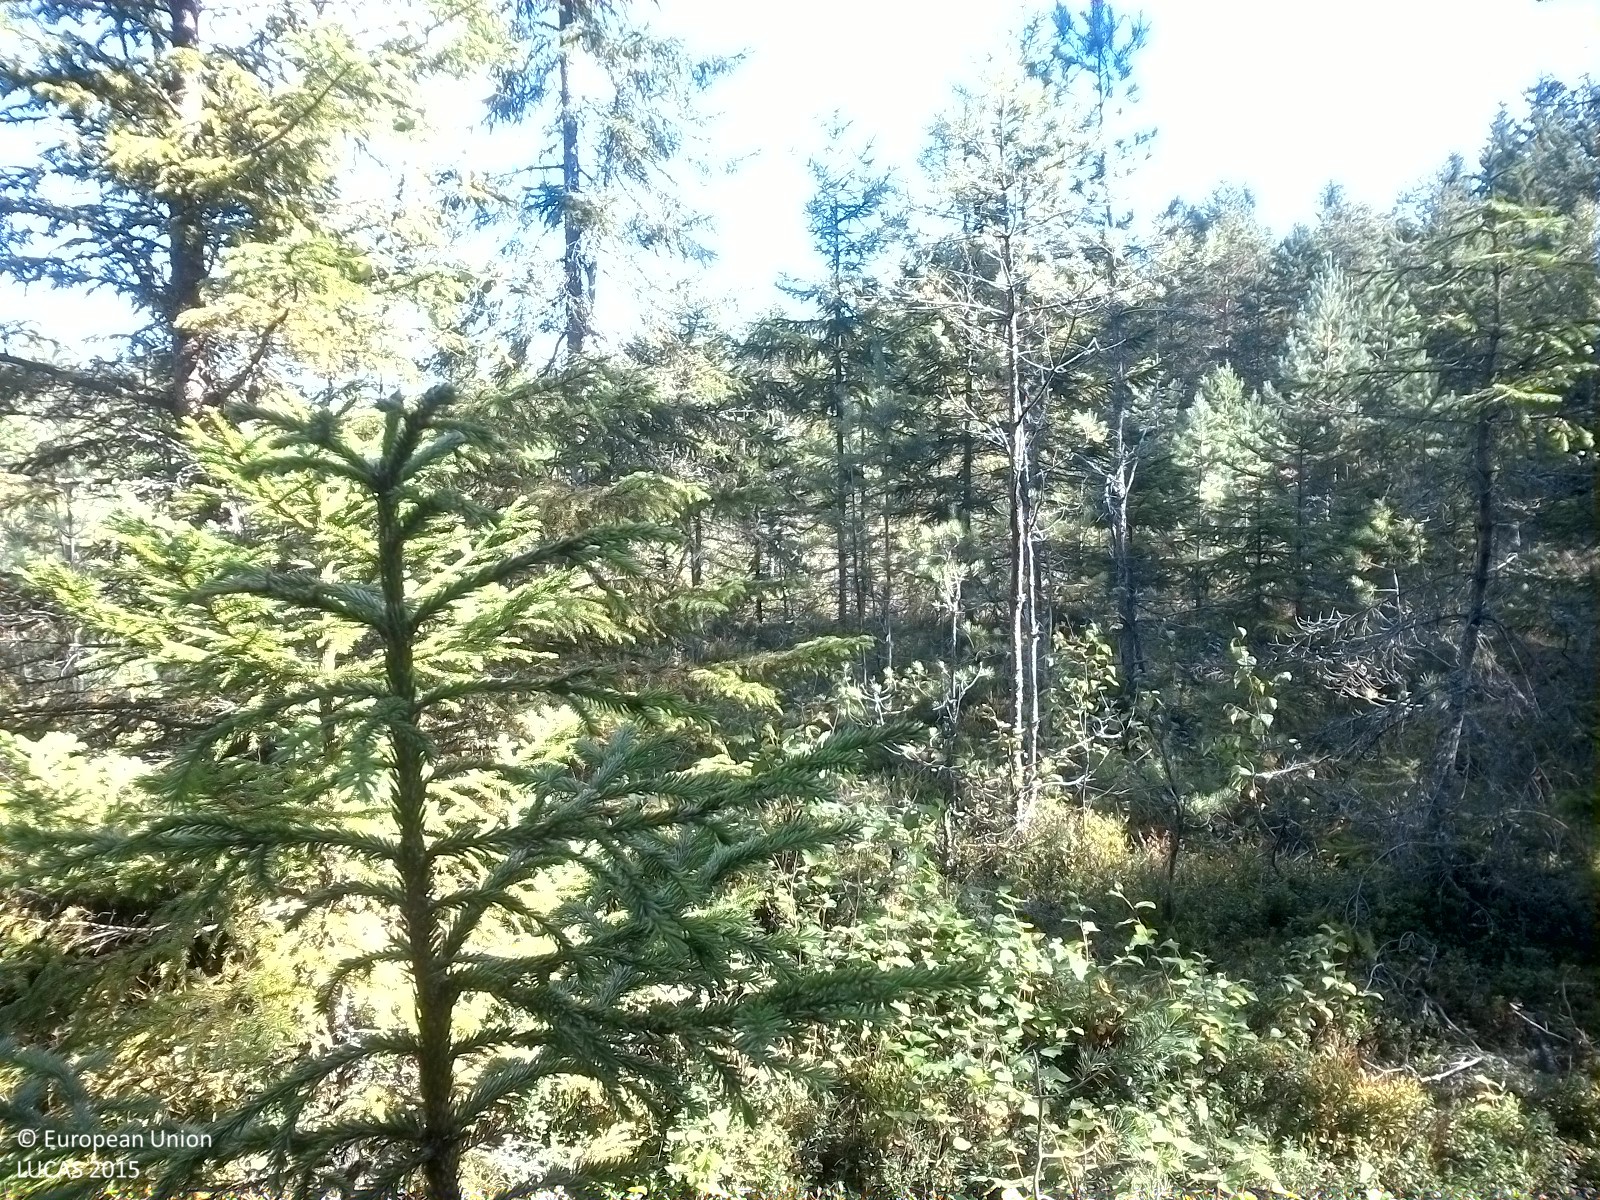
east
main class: Woodland
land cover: Spruce dominated mixed woodland
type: boreal forest
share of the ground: 50 - 75 %
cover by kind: coniferous forest trees 35 %, herbaceous plants 30 %, broadleaved forest trees 25 %, lichens and mosses 10 %
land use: Forestry
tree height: < 5 m
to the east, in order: Spruce dominated mixed woodland; Pine dominated mixed woodland; Spruce dominated coniferous woodland; Rivers and streams; Pine dominated coniferous woodland; Spruce dominated coniferous woodland; Tracks; Other mixed woodland; Pine dominated mixed woodland
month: September
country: SE
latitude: 59.0313
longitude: 15.8298
